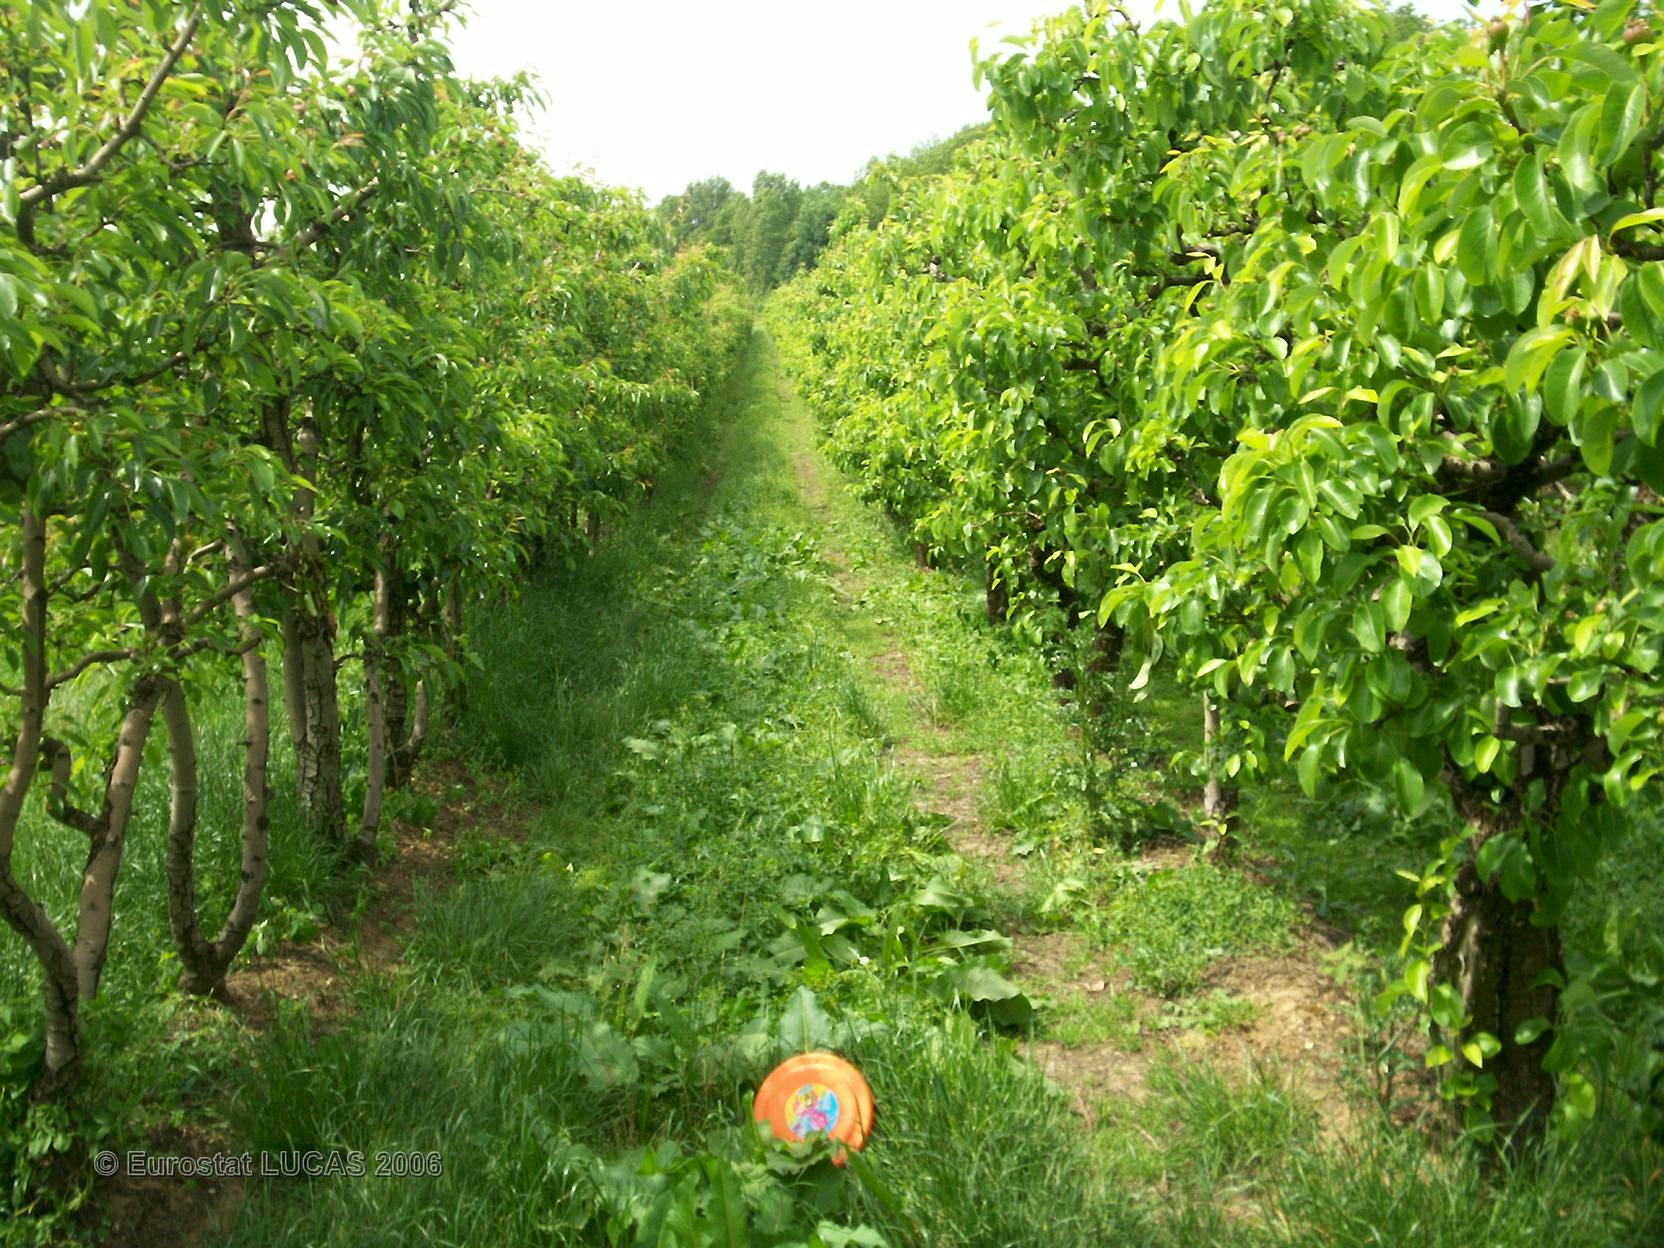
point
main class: Cropland
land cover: Pear fruit
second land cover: Grassland with sparse tree/shrub cover
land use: Agriculture (excluding fallow land and kitchen gardens)
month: May
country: FR
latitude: 45.6654
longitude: 4.8055
